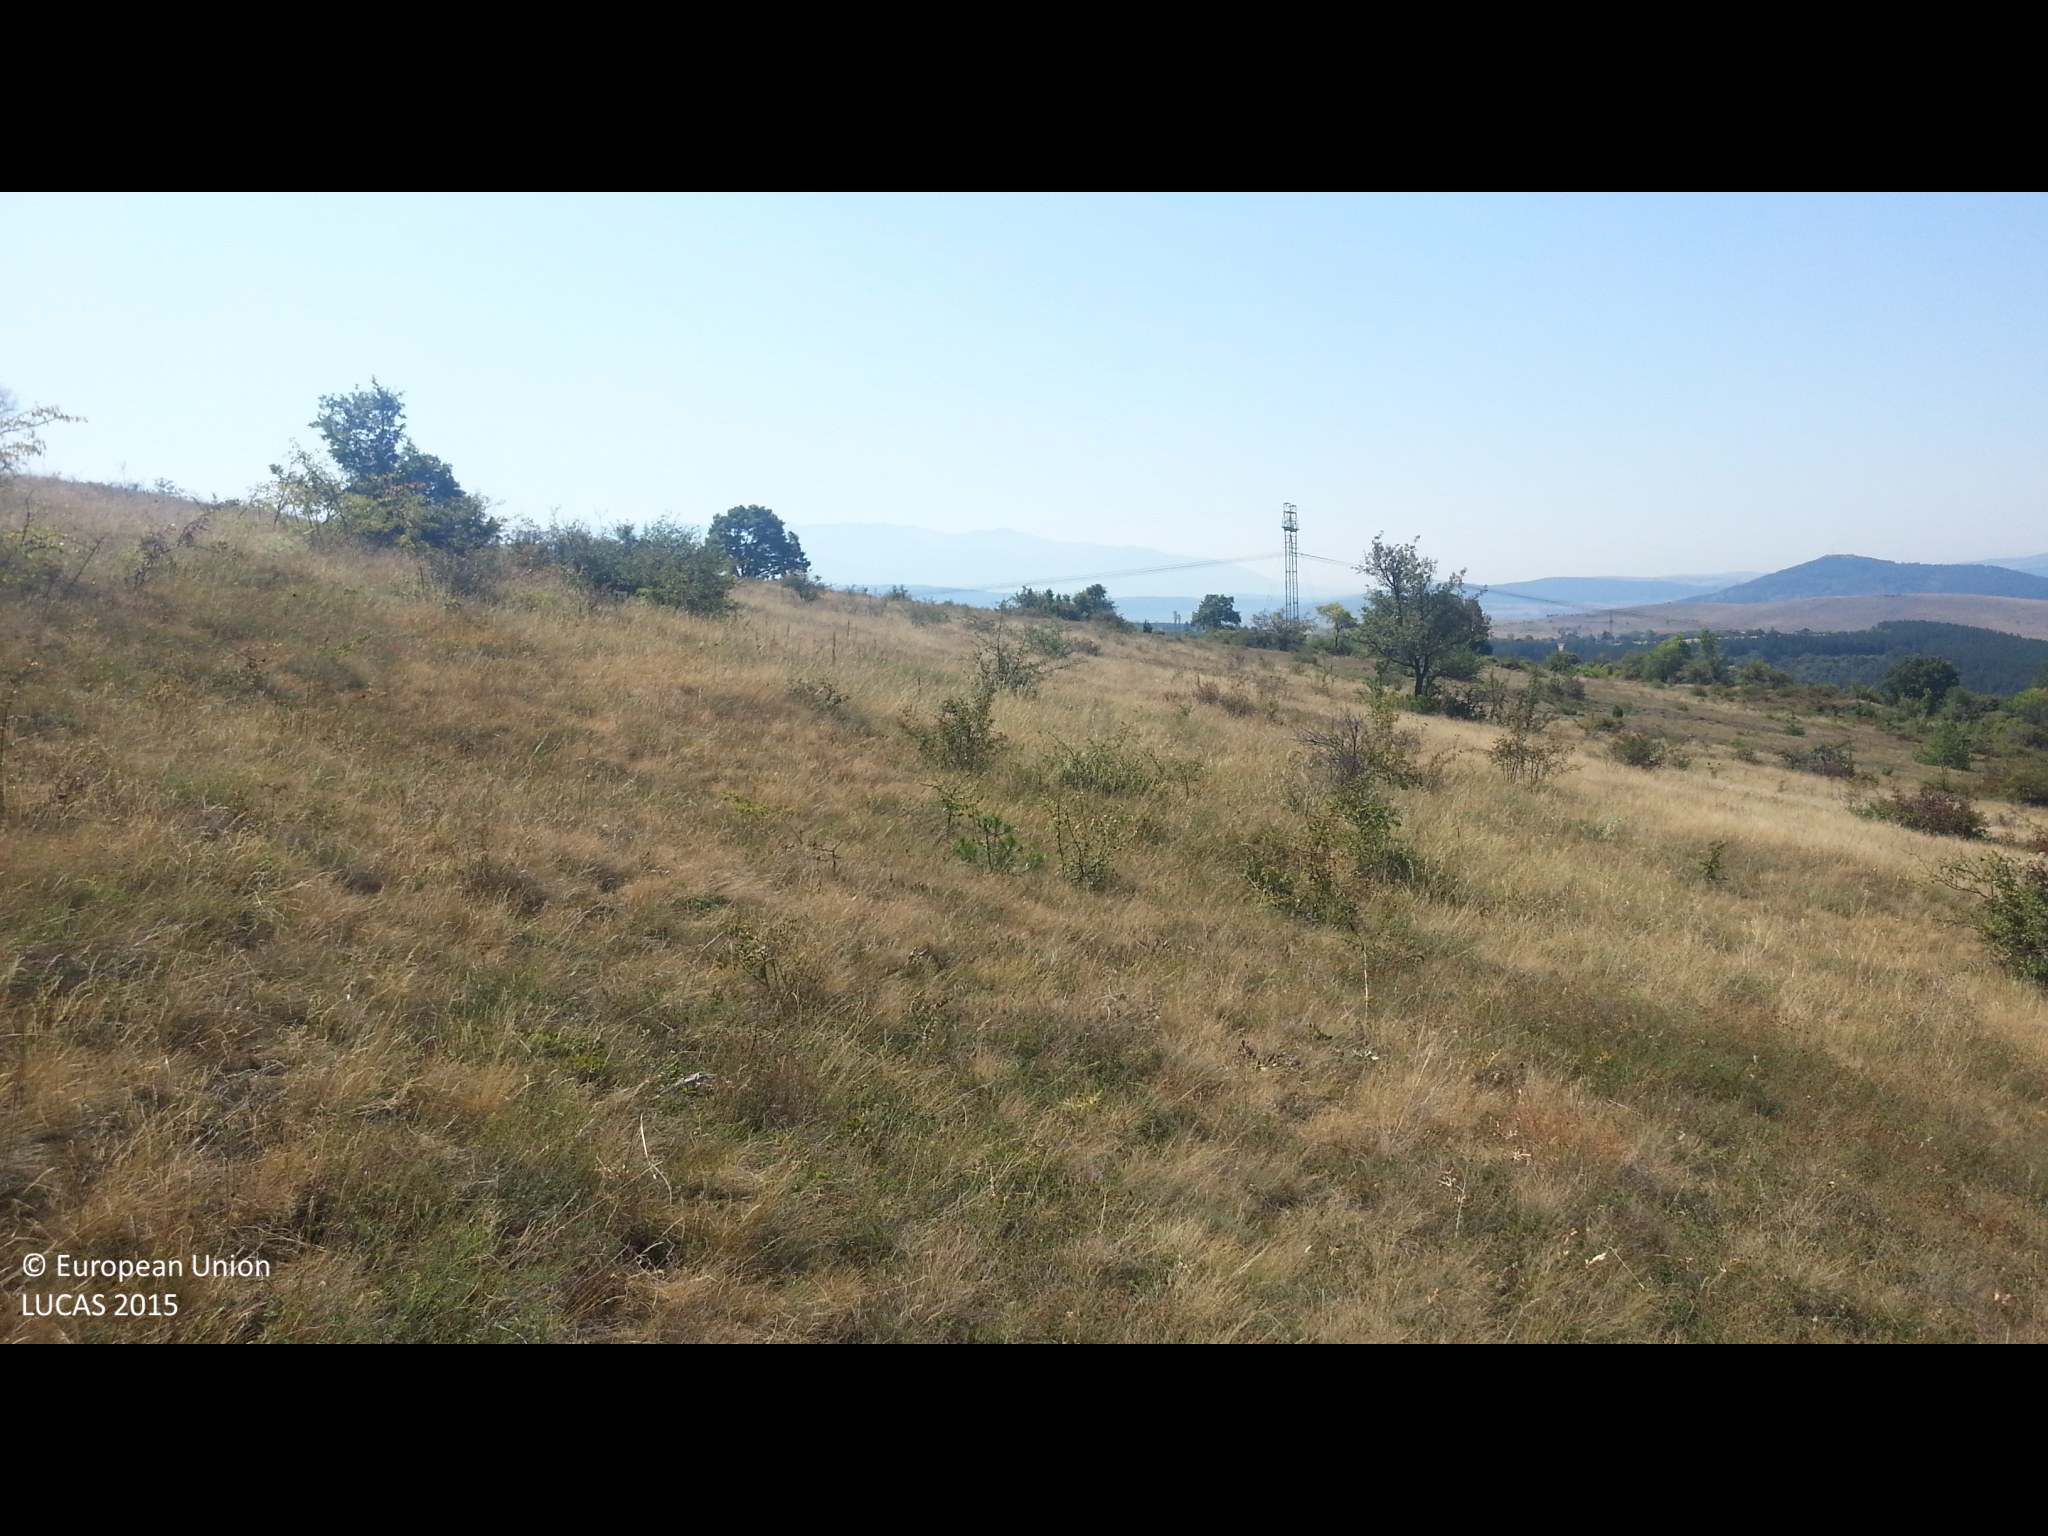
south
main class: Grassland
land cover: Grassland with sparse tree/shrub cover
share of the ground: > 75 %
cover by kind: herbaceous plants 90 %, broadleaved forest trees 5 %, shrubs 5 %
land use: Agriculture (excluding fallow land and kitchen gardens)
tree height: < 5 m
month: August
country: BG
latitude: 42.4923
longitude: 23.1088
